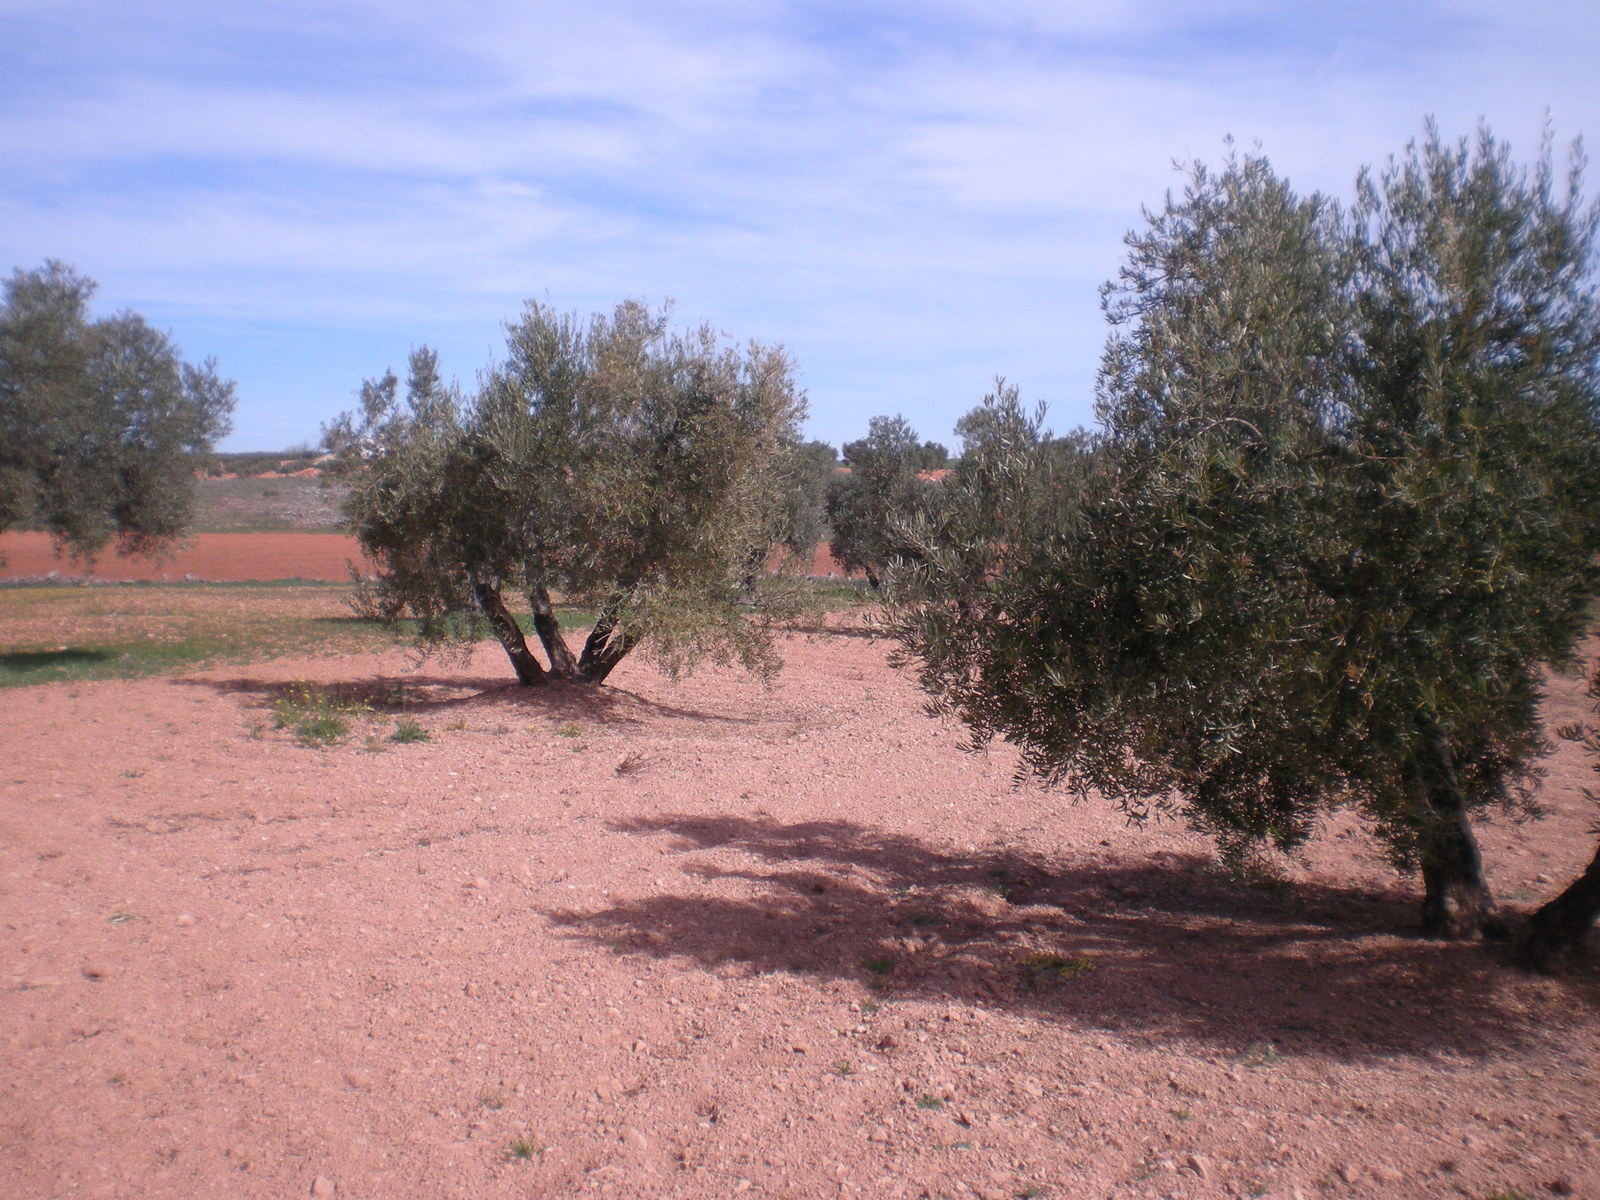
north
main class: Cropland
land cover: Olive groves
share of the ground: 10 - 25 %
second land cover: Other bare soil
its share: > 75 %
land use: Agriculture (excluding fallow land and kitchen gardens)
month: March
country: ES
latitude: 38.9824
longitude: -3.2301
